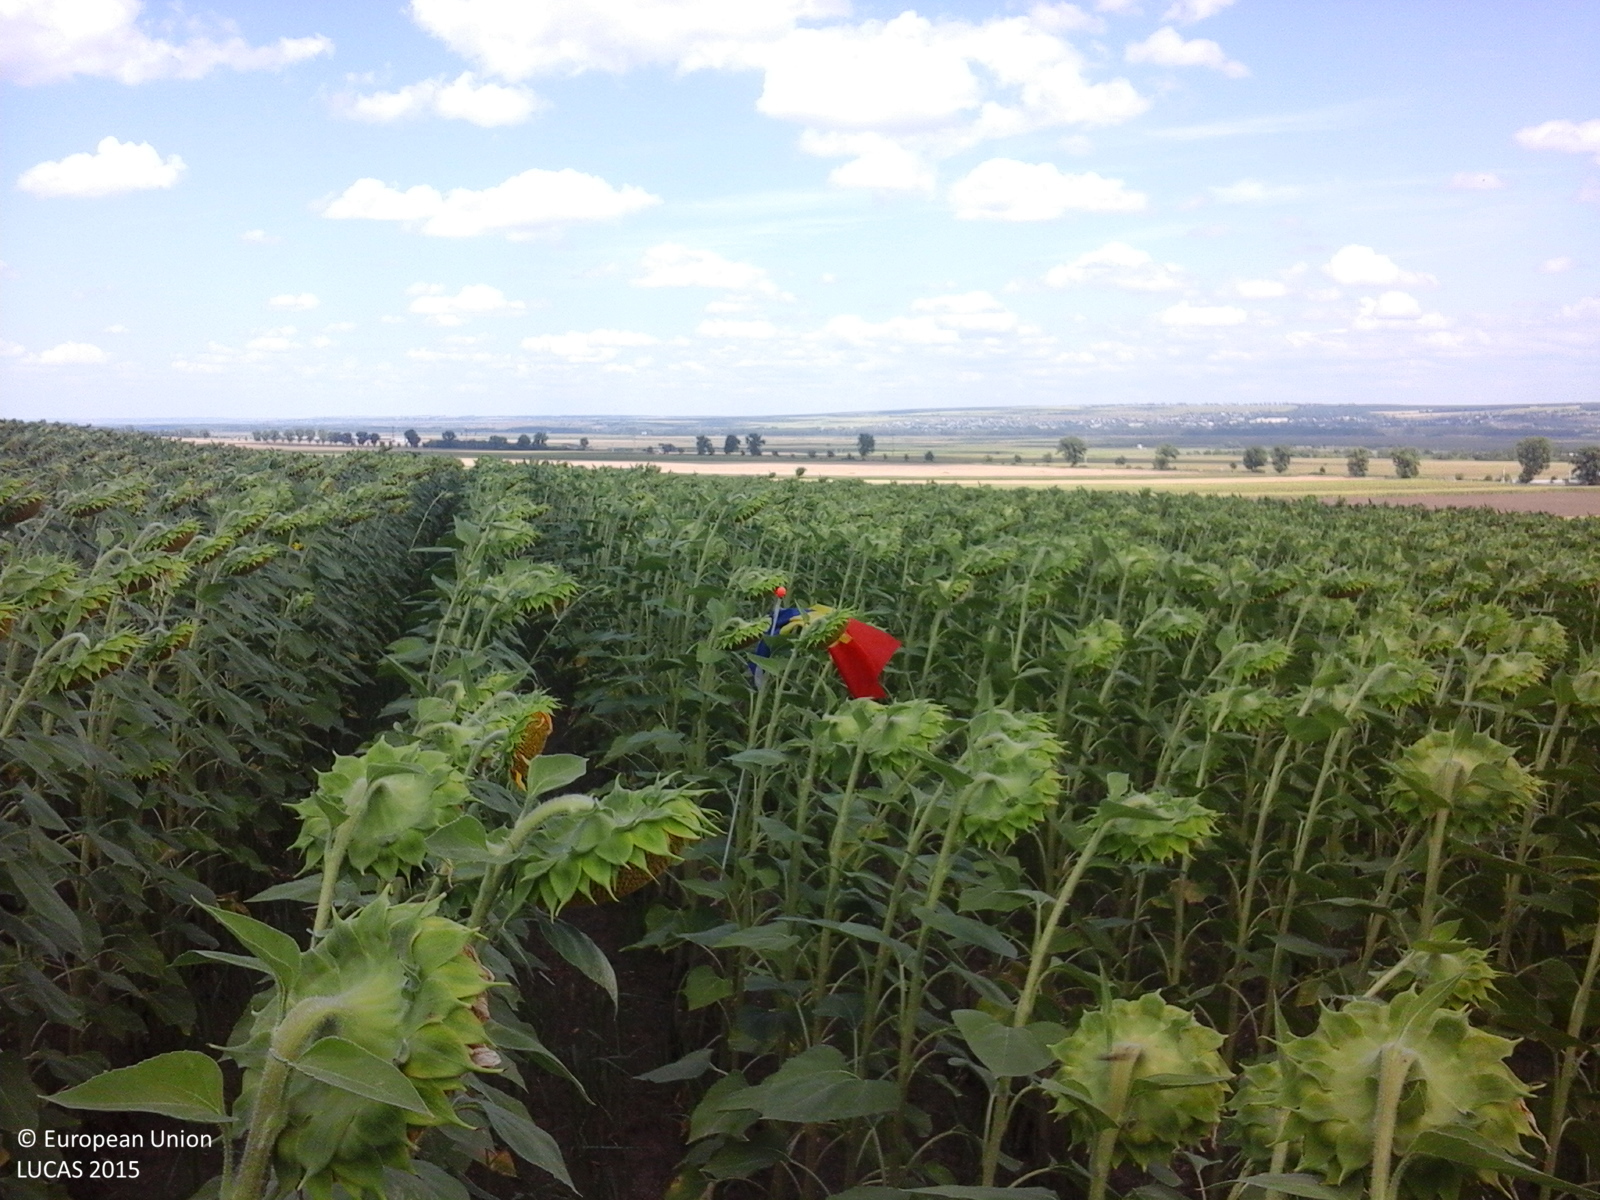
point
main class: Cropland
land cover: Sunflower
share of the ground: > 75 %
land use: Agriculture (excluding fallow land and kitchen gardens)
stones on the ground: < 10 %
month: July
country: RO
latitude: 46.4356
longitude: 28.1836
